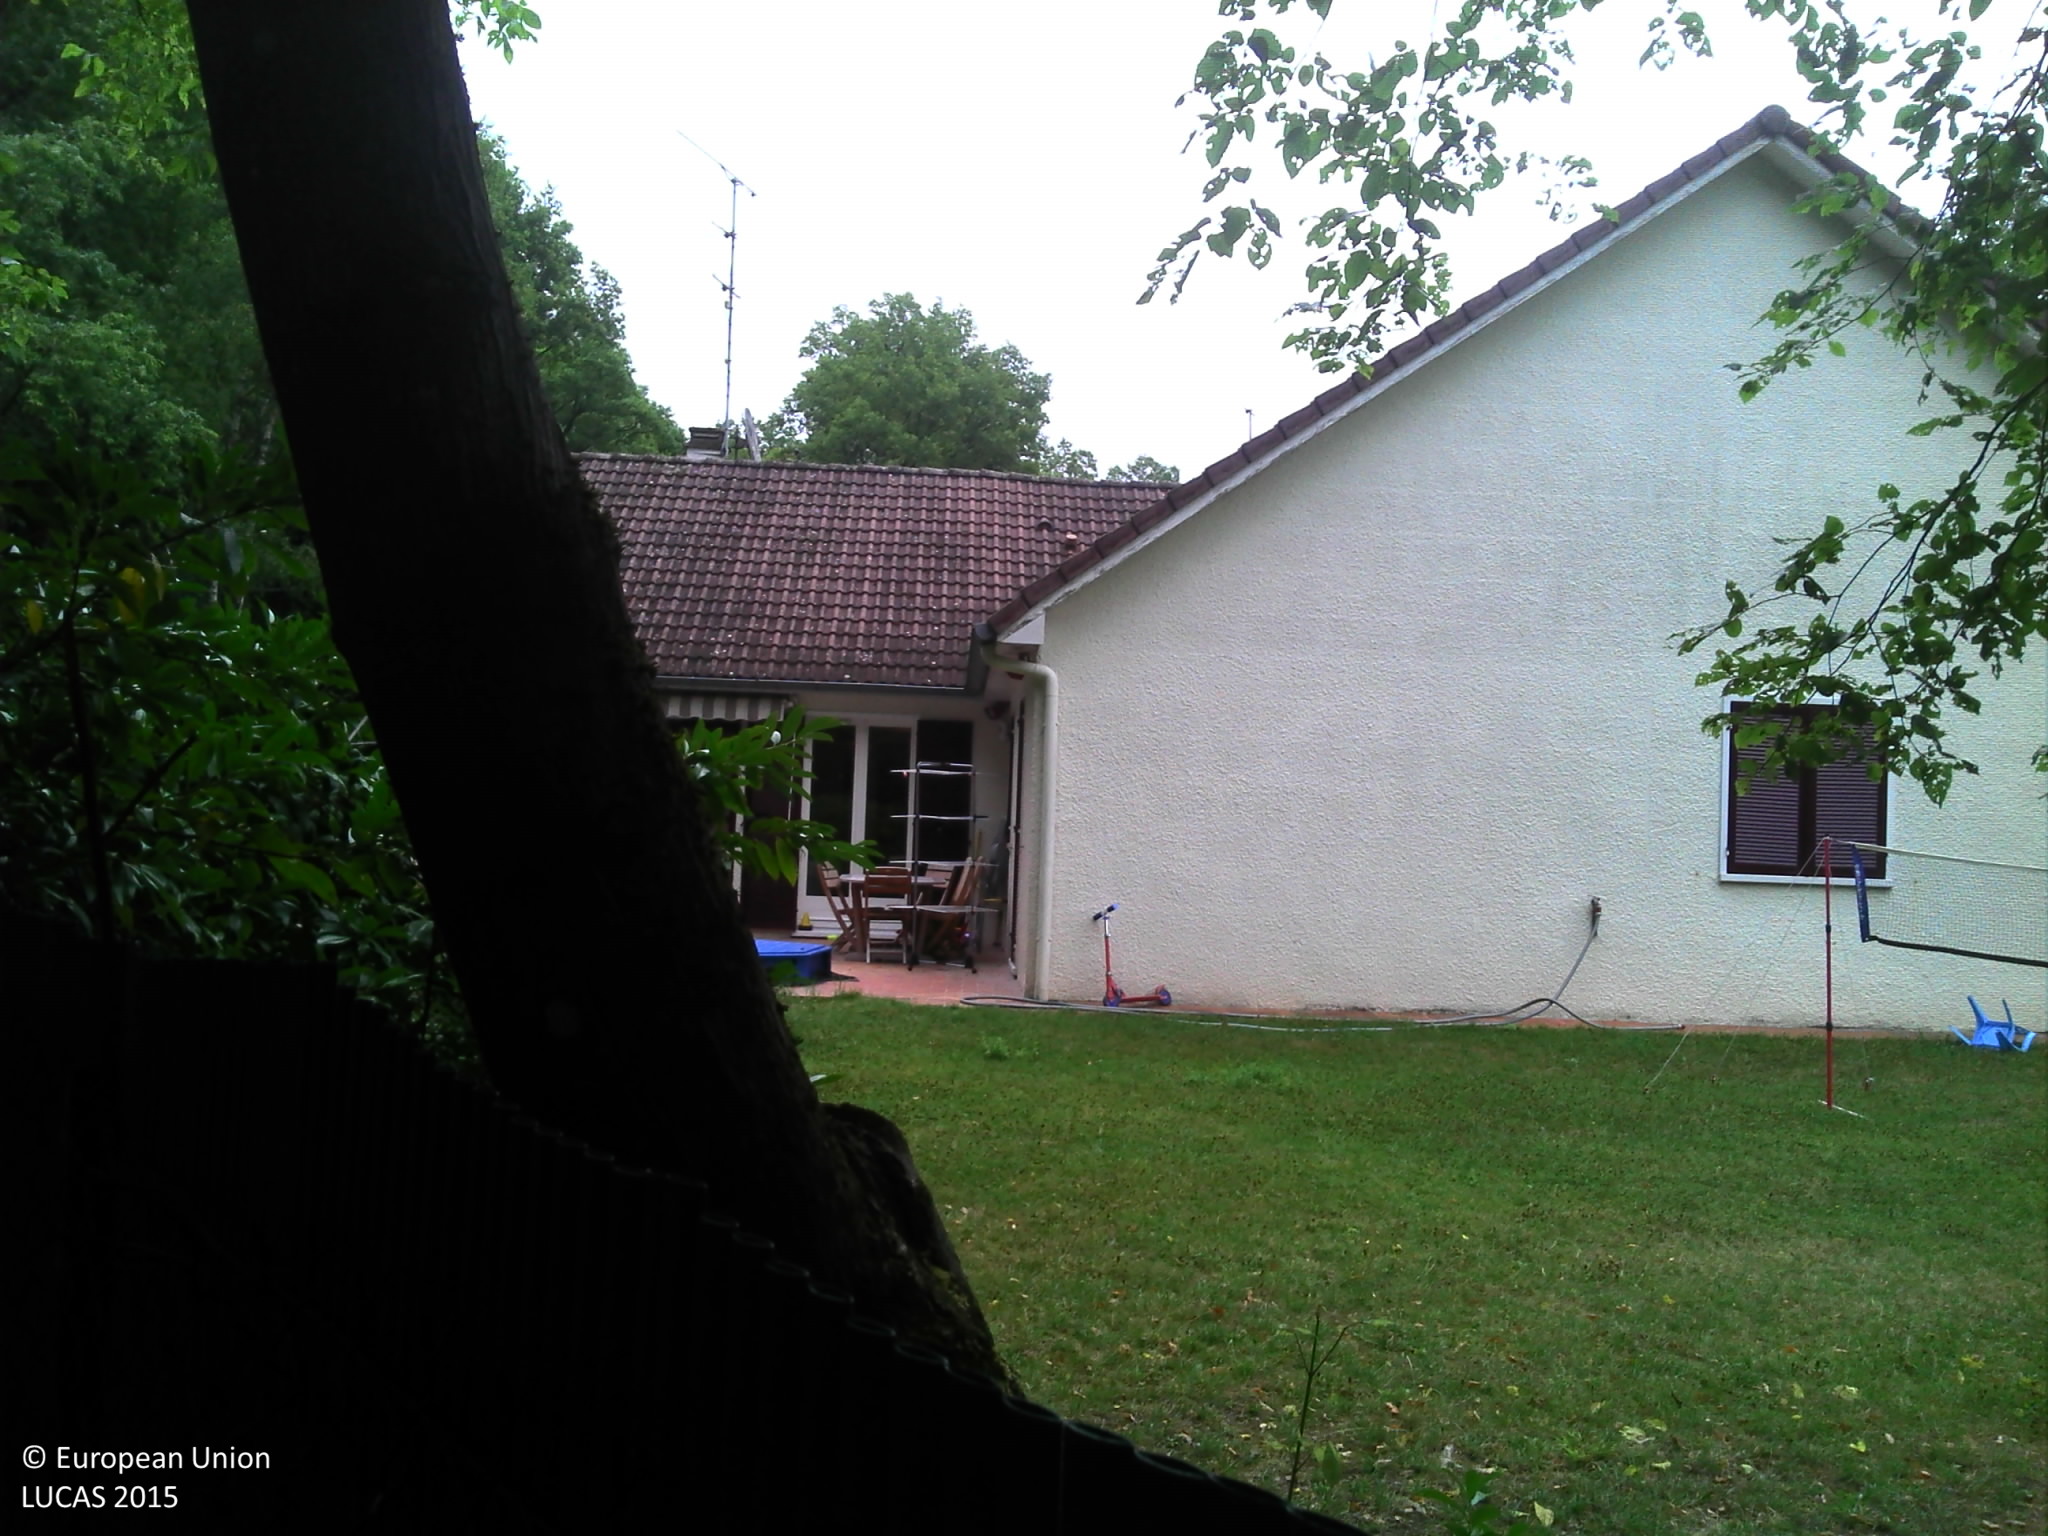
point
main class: Grassland
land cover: Grassland with sparse tree/shrub cover
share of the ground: > 75 %
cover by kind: herbaceous plants 80 %, lichens and mosses 10 %, broadleaved forest trees 5 %, consolidated bare surface 5 %
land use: Residential
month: July
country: FR
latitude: 48.7572
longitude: 2.6852
